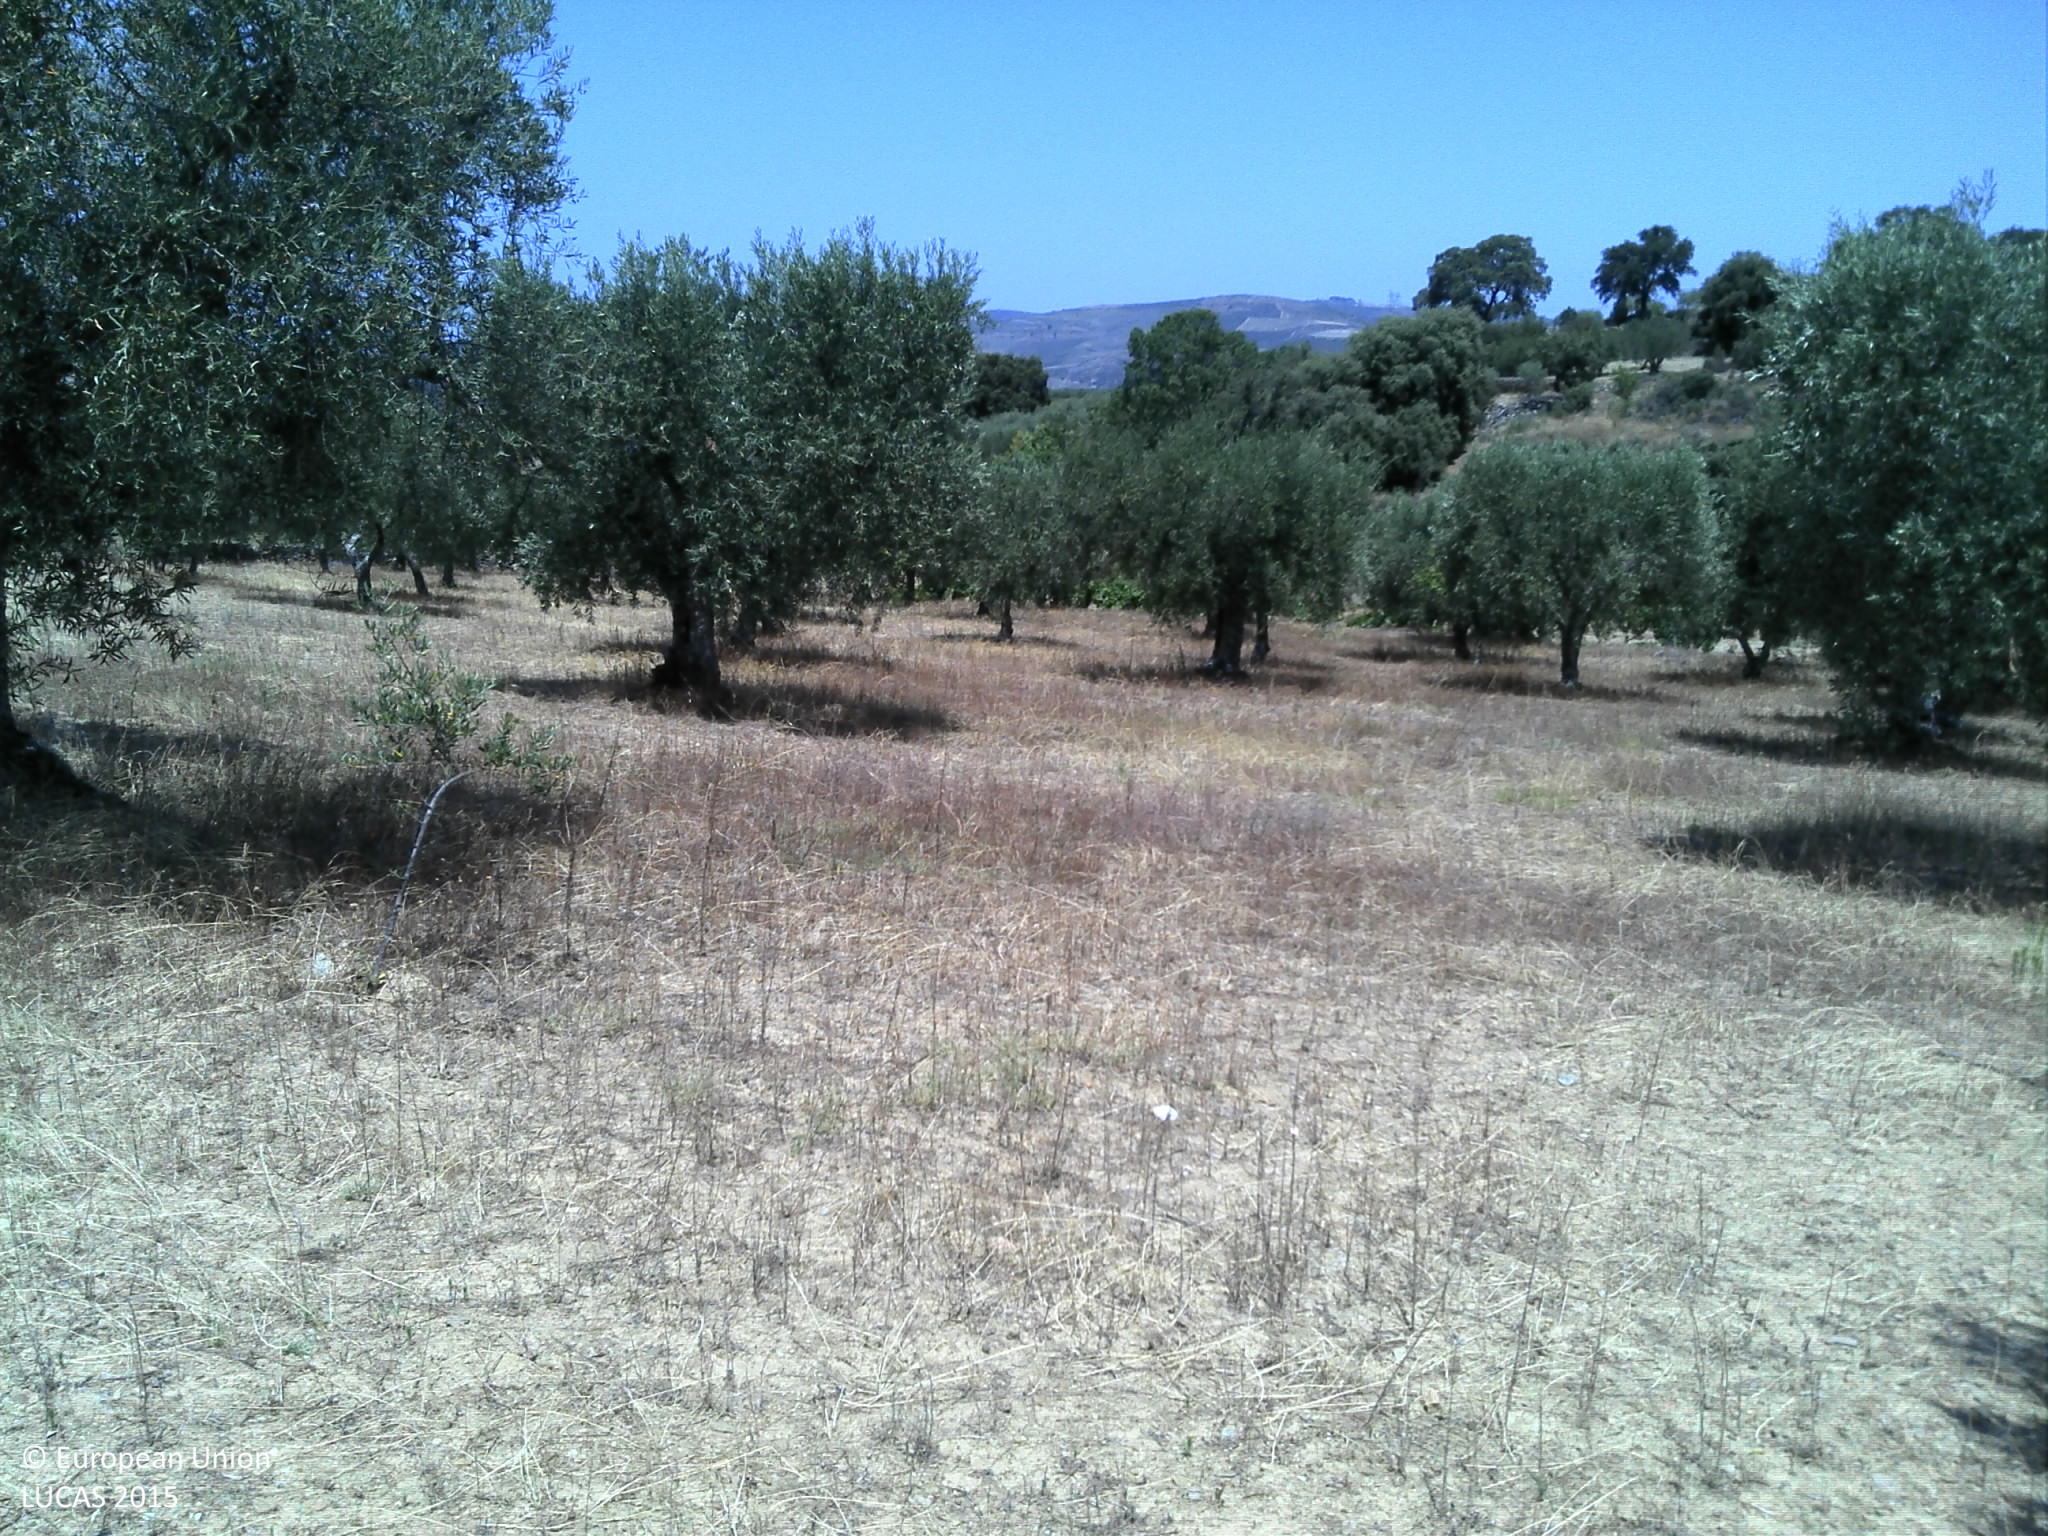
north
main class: Cropland
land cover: Olive groves
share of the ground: 25 - 50 %
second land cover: Grassland without tree/shrub cover
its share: < 10 %
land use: Agriculture (excluding fallow land and kitchen gardens)
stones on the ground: 10 - 25 %
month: July
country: PT
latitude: 41.0902
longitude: -7.4406
